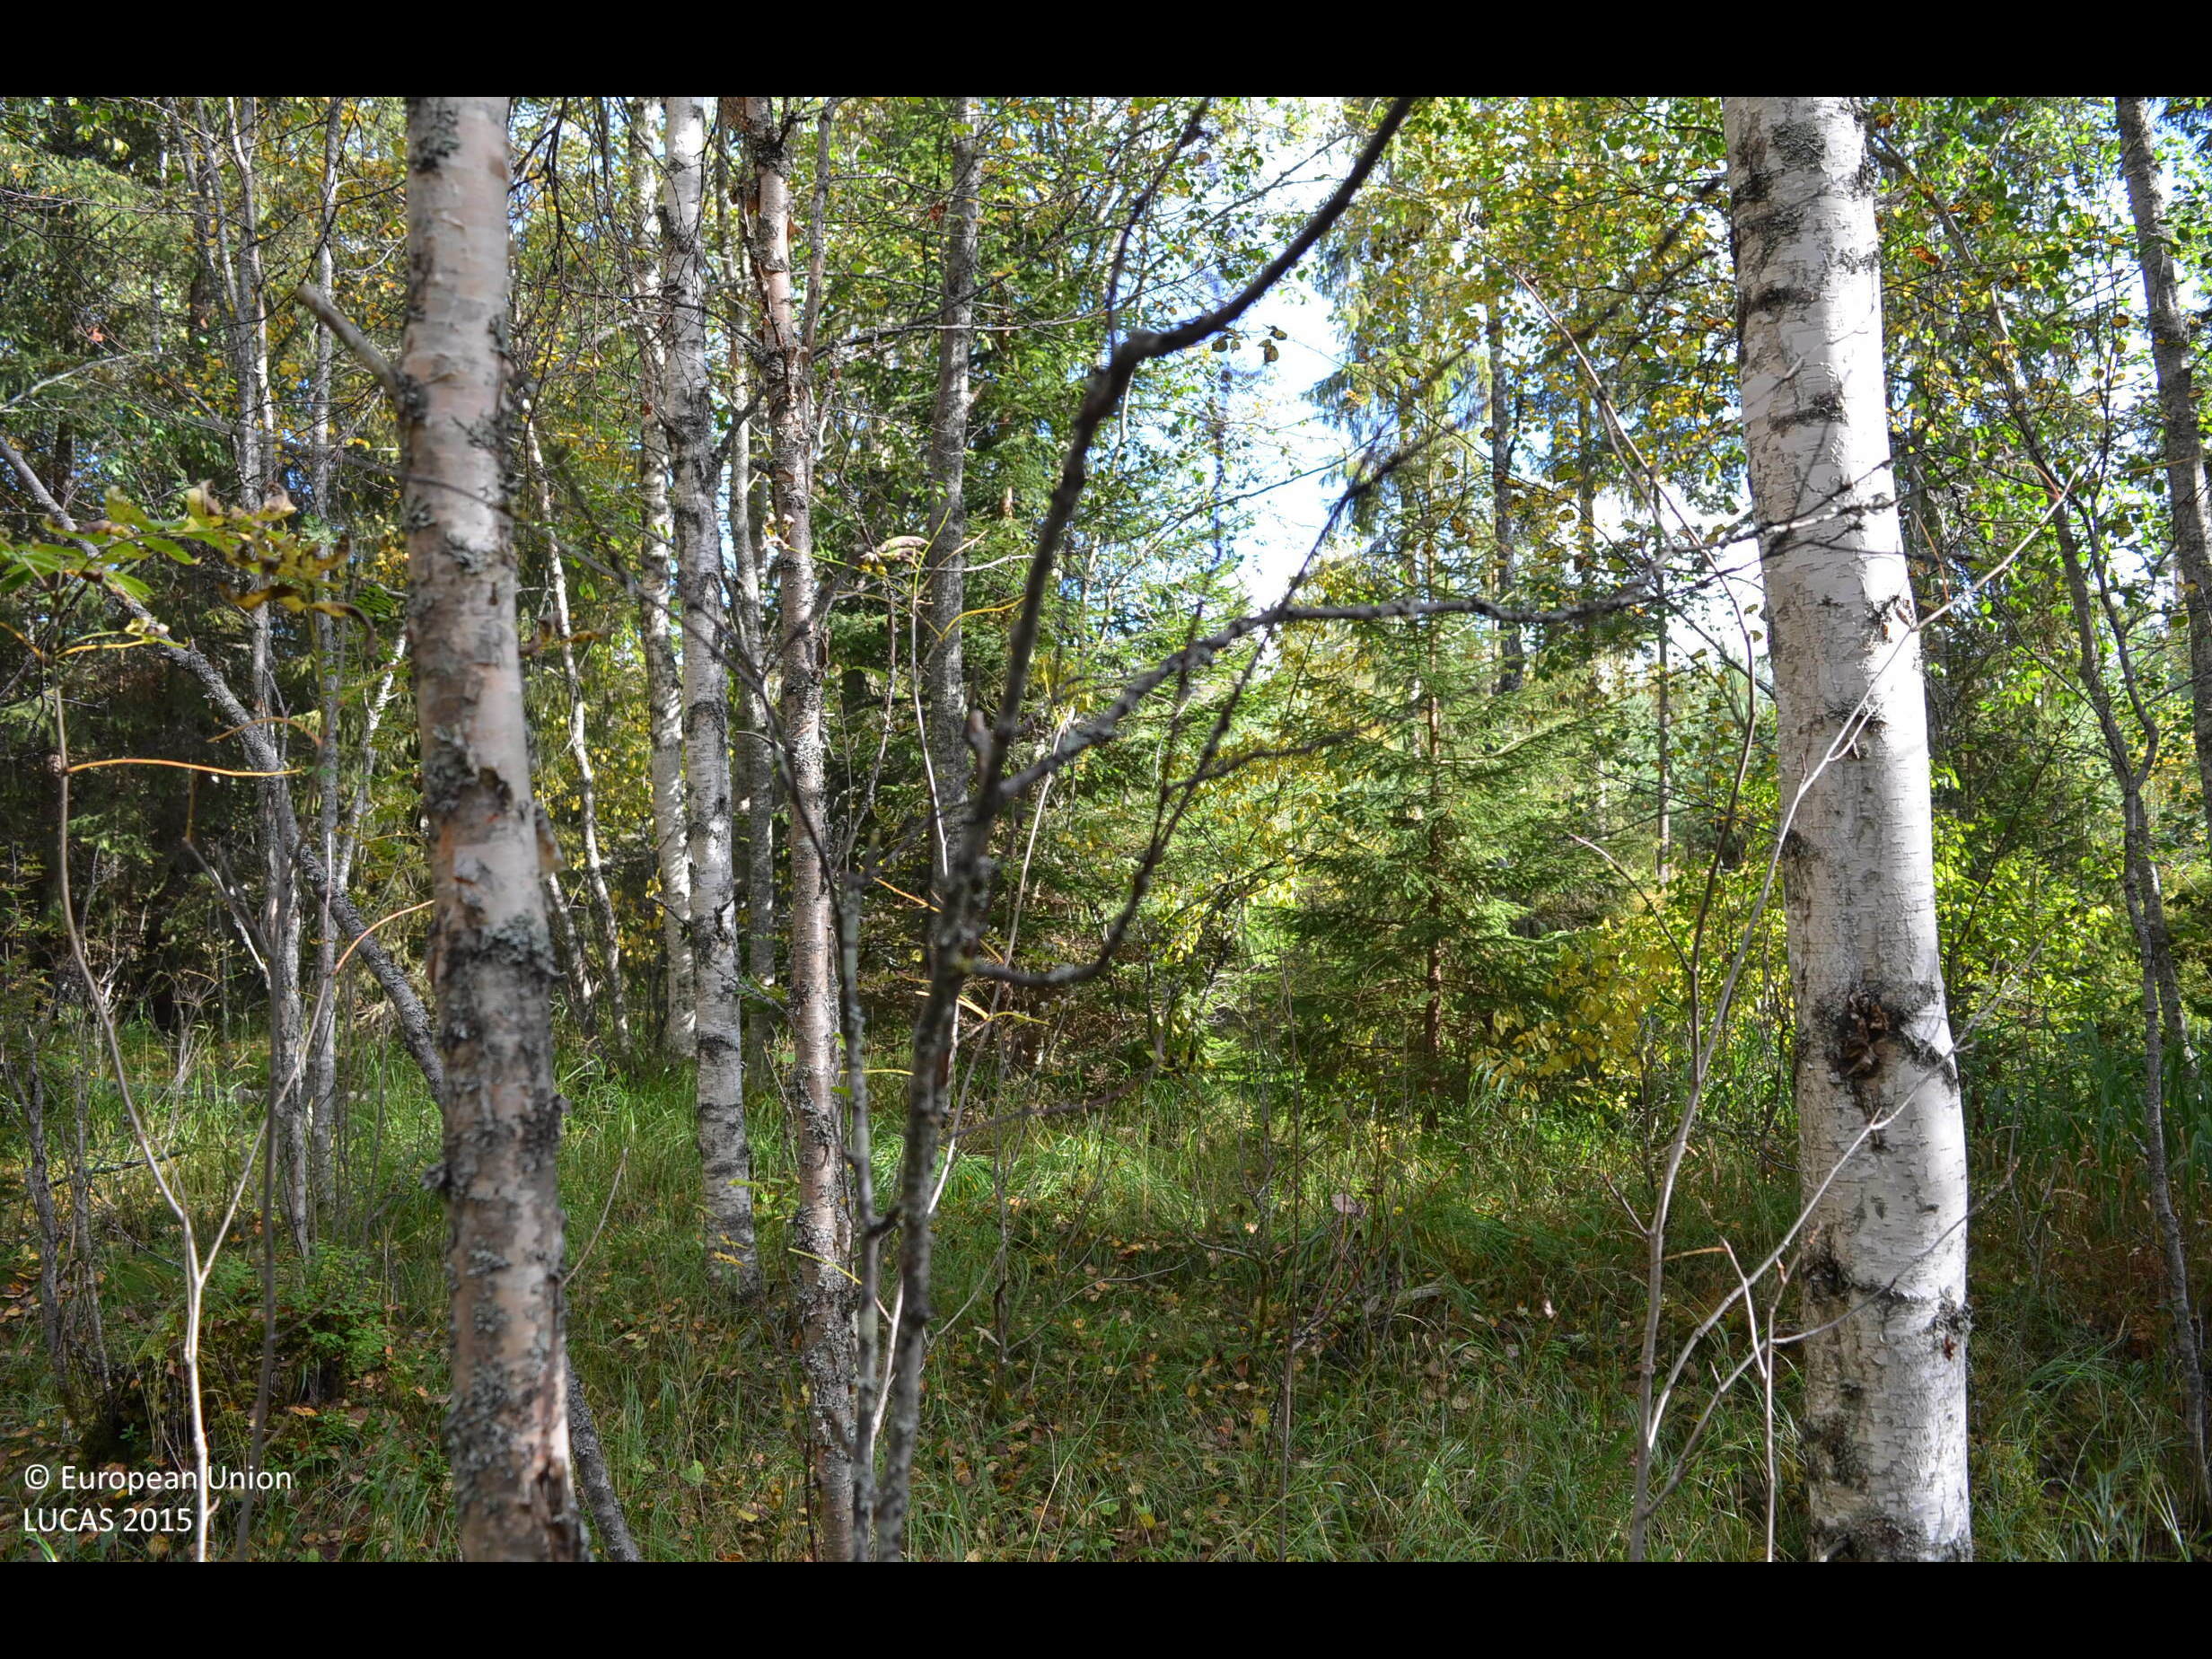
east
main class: Woodland
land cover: Spruce dominated mixed woodland
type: boreal forest
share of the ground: > 75 %
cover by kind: broadleaved forest trees 50 %, coniferous forest trees 25 %, herbaceous plants 20 %, shrubs 5 %
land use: Forestry
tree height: > 5 m
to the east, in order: Spruce dominated mixed woodland; Rivers and streams; Spruce dominated mixed woodland; Pine dominated coniferous woodland; Spruce dominated mixed woodland; Rivers and streams; Other mixed woodland; Pine dominated mixed woodland; Pine dominated coniferous woodland; Ditches and canals; Pine dominated mixed woodland
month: September
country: FI
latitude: 62.9277
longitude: 23.7998
